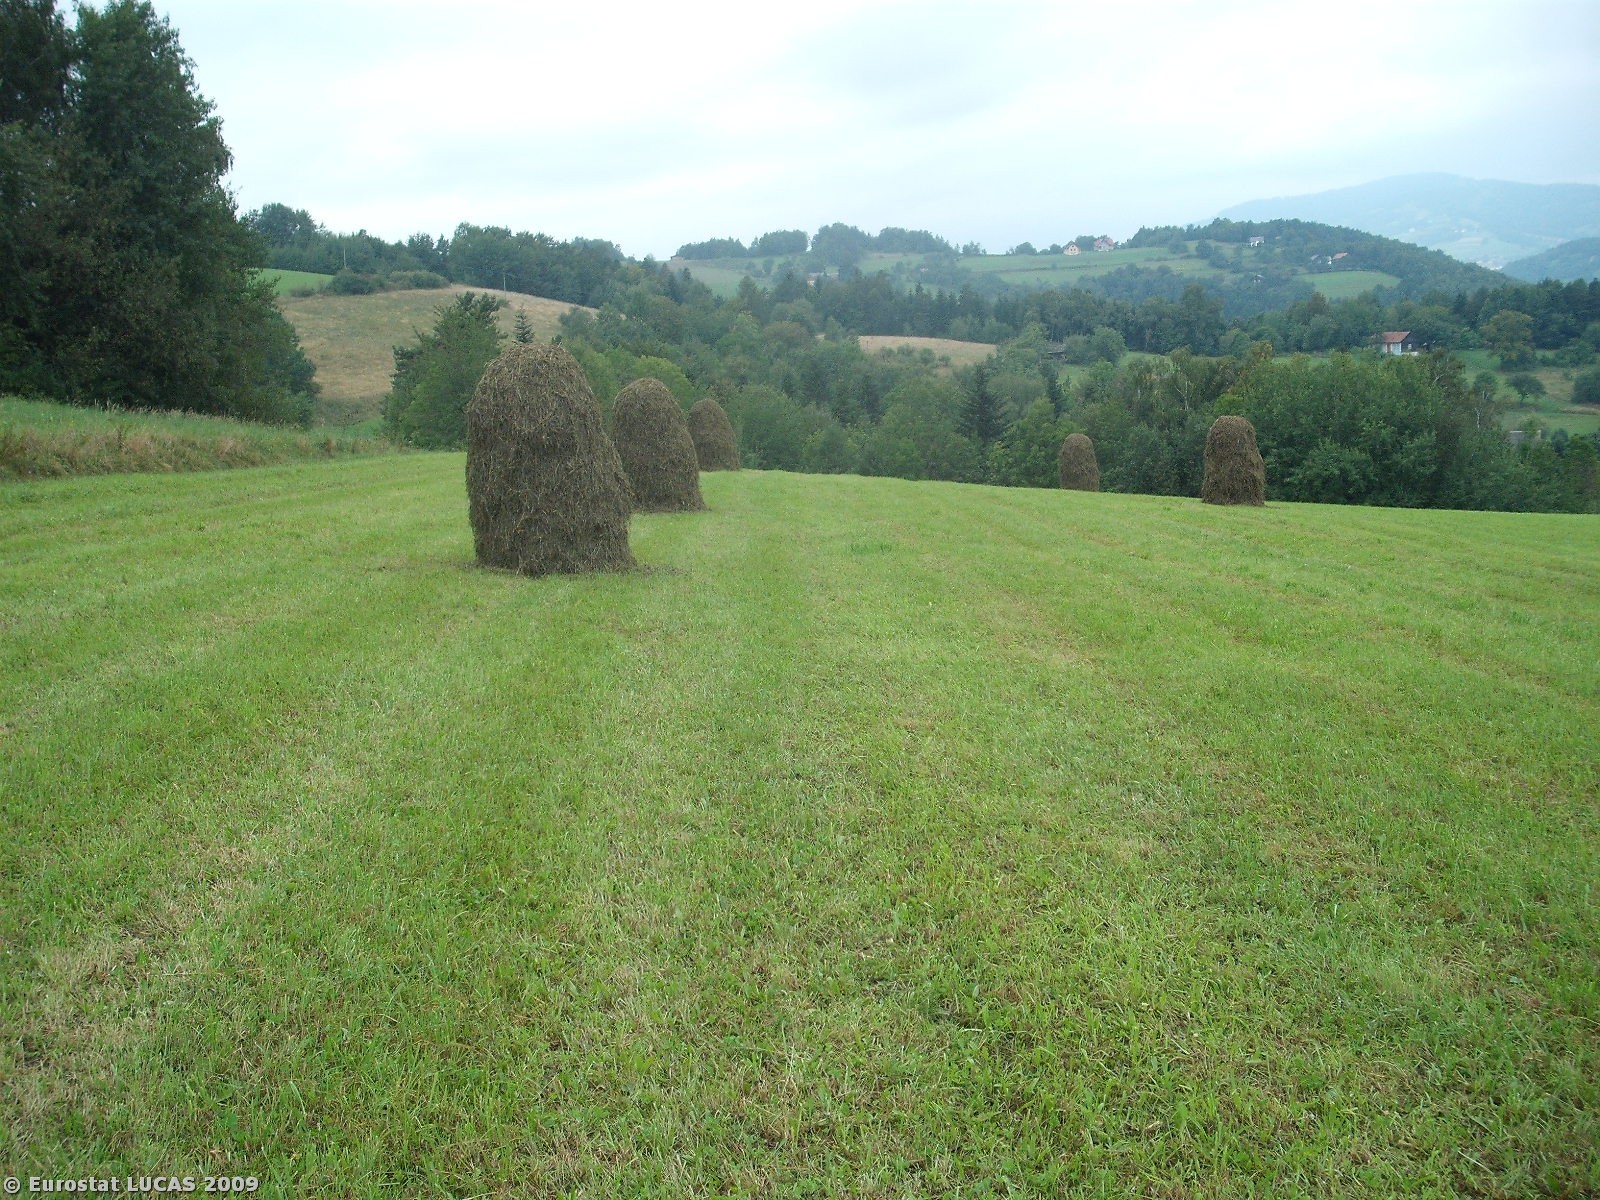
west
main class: Grassland
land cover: Grassland without tree/shrub cover
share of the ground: > 75 %
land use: Agriculture (excluding fallow land and kitchen gardens)
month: September
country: PL
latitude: 49.7535
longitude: 20.4888
